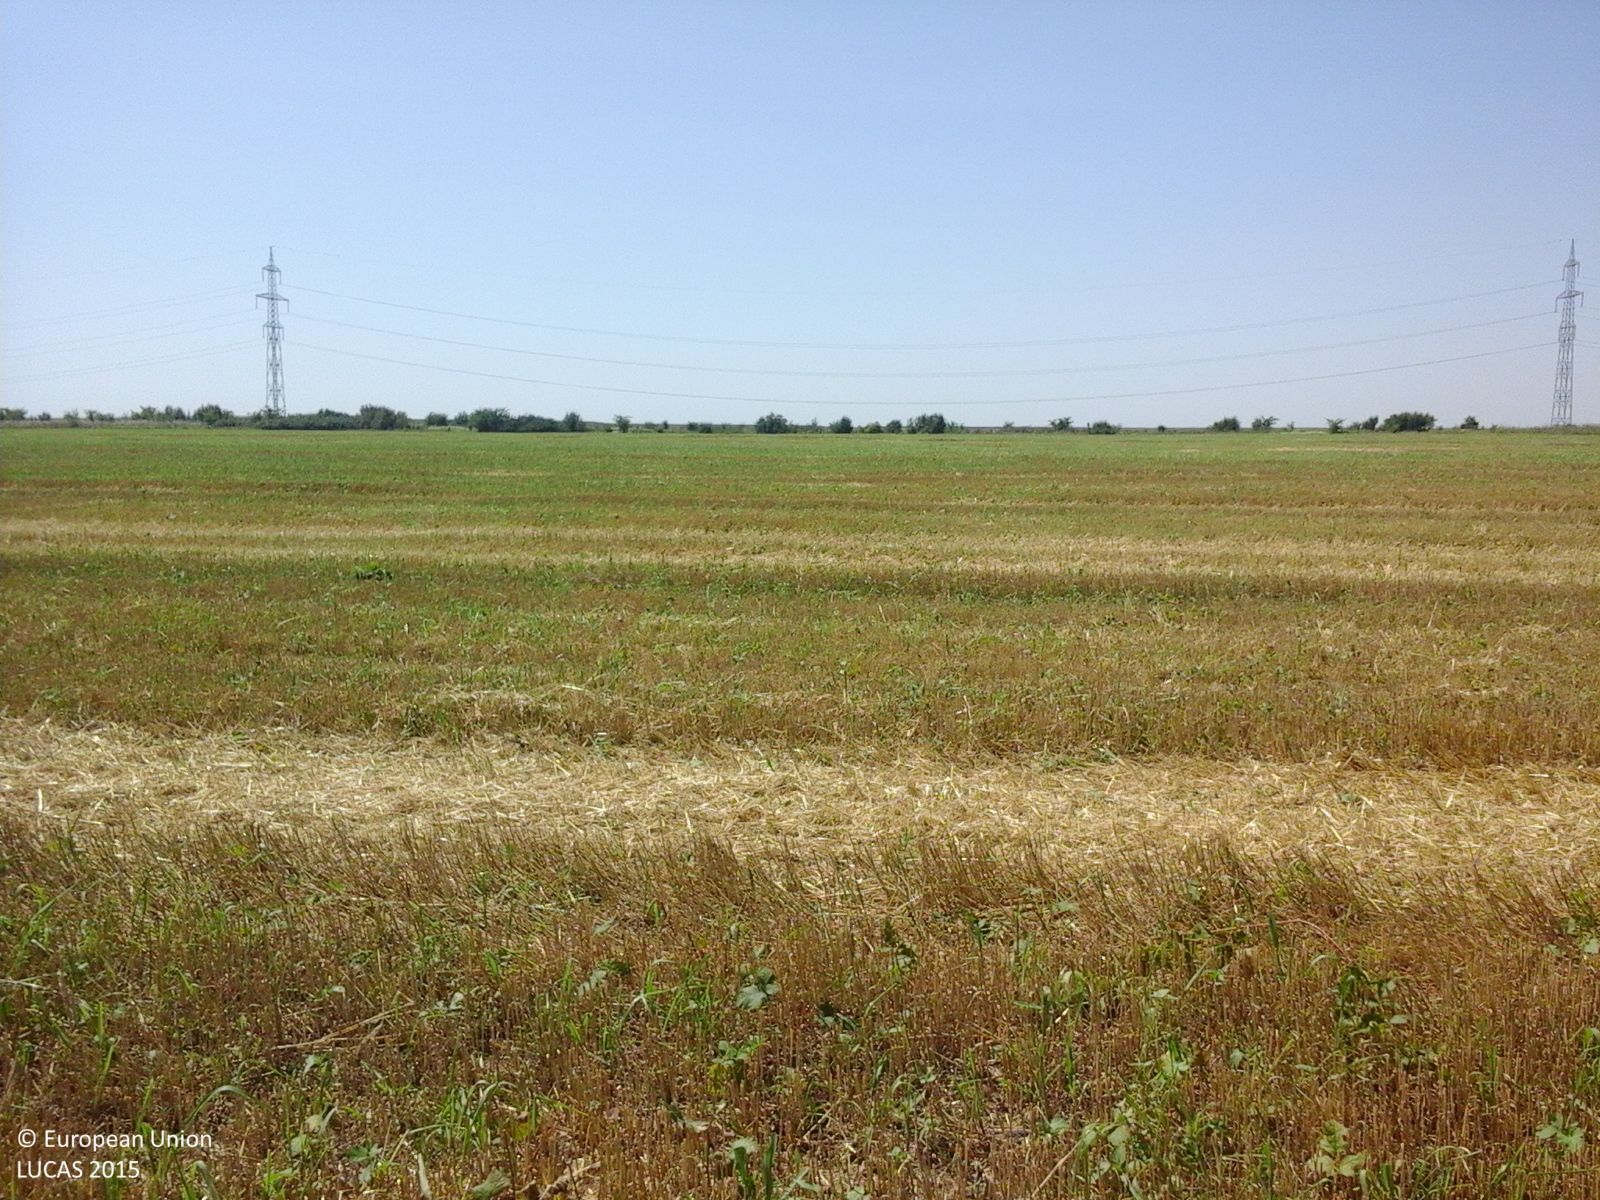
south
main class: Cropland
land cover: Common wheat
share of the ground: < 10 %
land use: Agriculture (excluding fallow land and kitchen gardens)
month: July
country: RO
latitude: 44.4051
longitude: 26.4496
